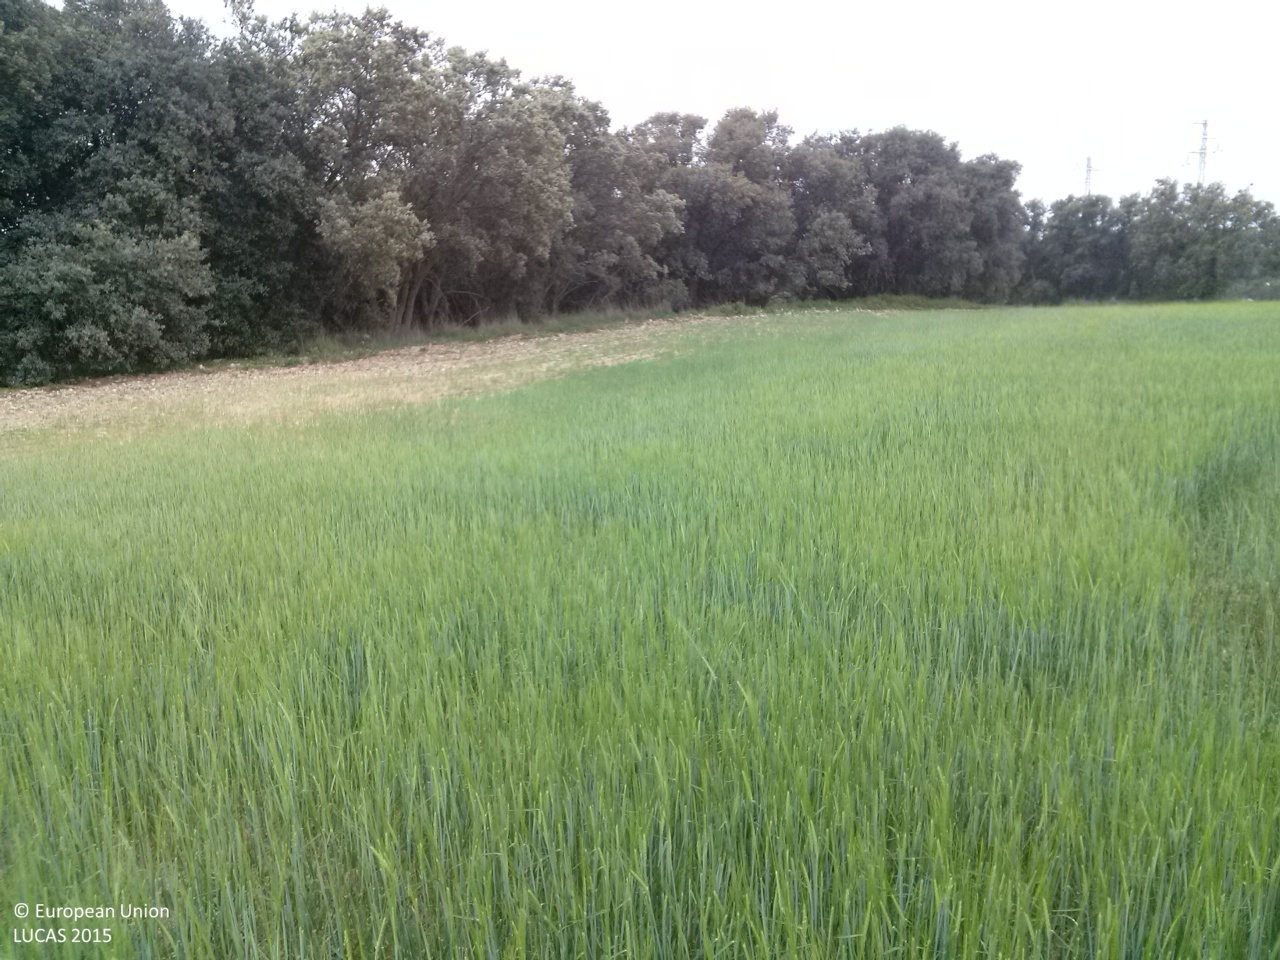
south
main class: Cropland
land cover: Barley
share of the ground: > 75 %
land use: Agriculture (excluding fallow land and kitchen gardens)
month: May
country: ES
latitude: 39.8763
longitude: -2.8467
